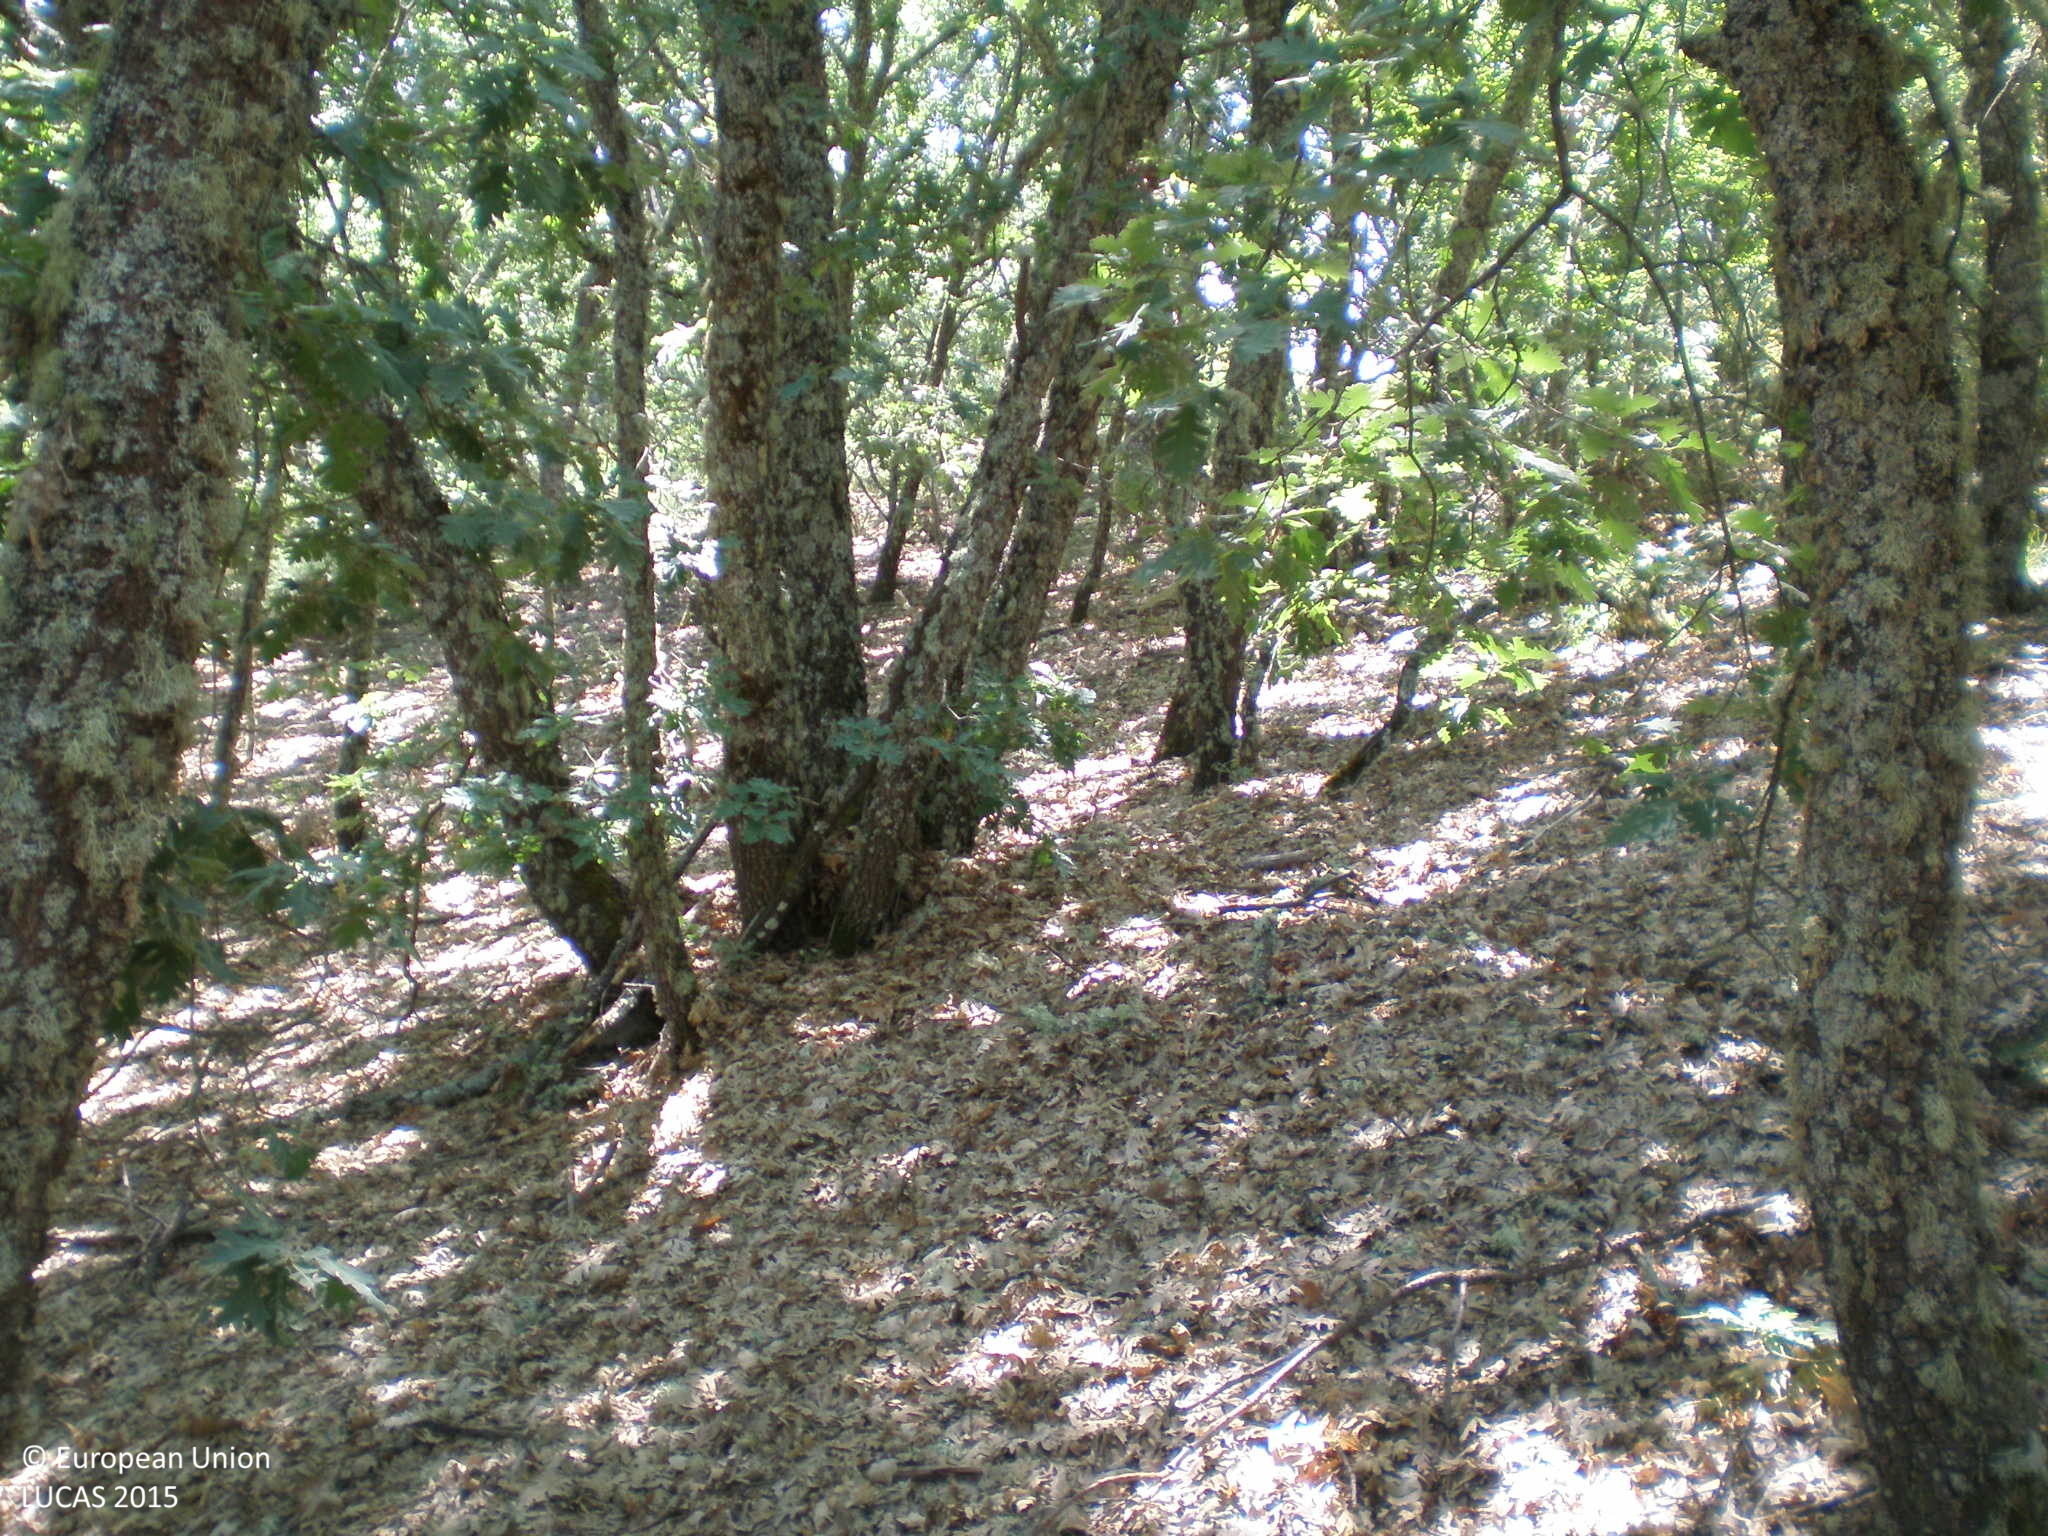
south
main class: Woodland
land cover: Broadleaved woodland
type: thermophilous deciduous forest
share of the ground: > 75 %
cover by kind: broadleaved forest trees 100 %
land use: Forestry
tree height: > 5 m
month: June
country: ES
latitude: 40.3217
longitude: -5.5652
